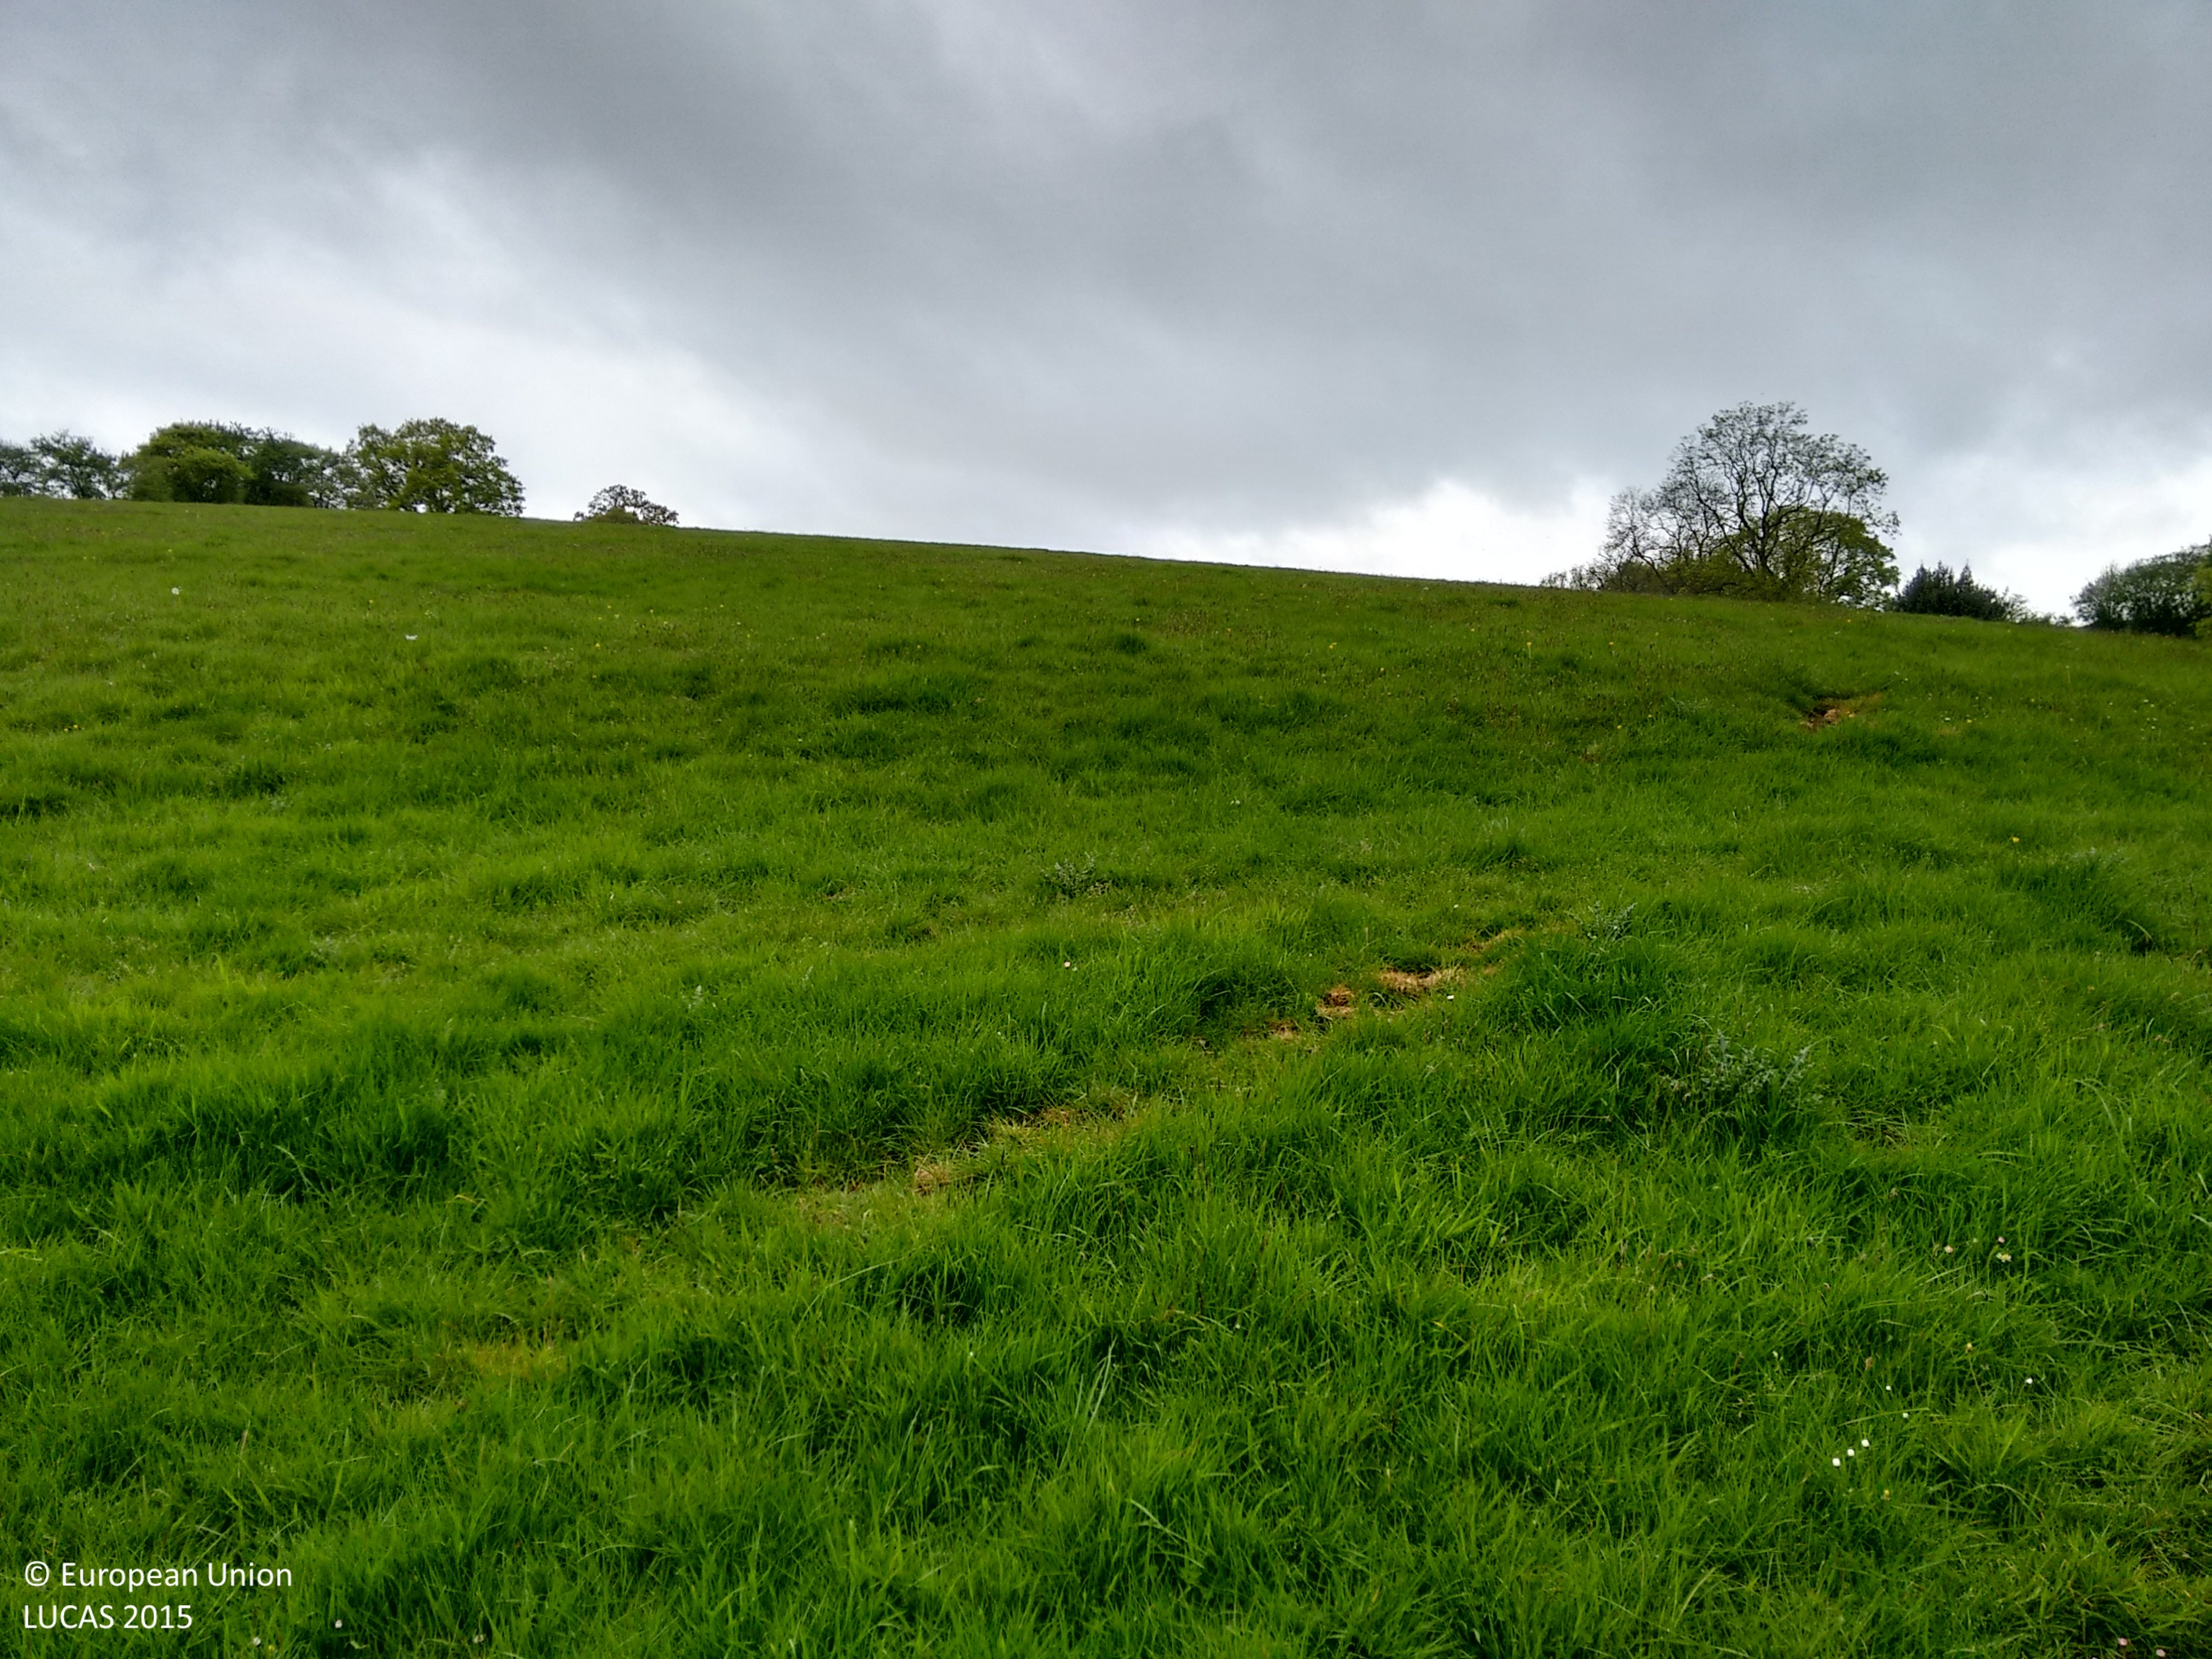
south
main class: Grassland
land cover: Grassland without tree/shrub cover
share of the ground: > 75 %
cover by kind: herbaceous plants 100 %
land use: Agriculture (excluding fallow land and kitchen gardens)
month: May
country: GB
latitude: 52.2974
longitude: -2.4860
